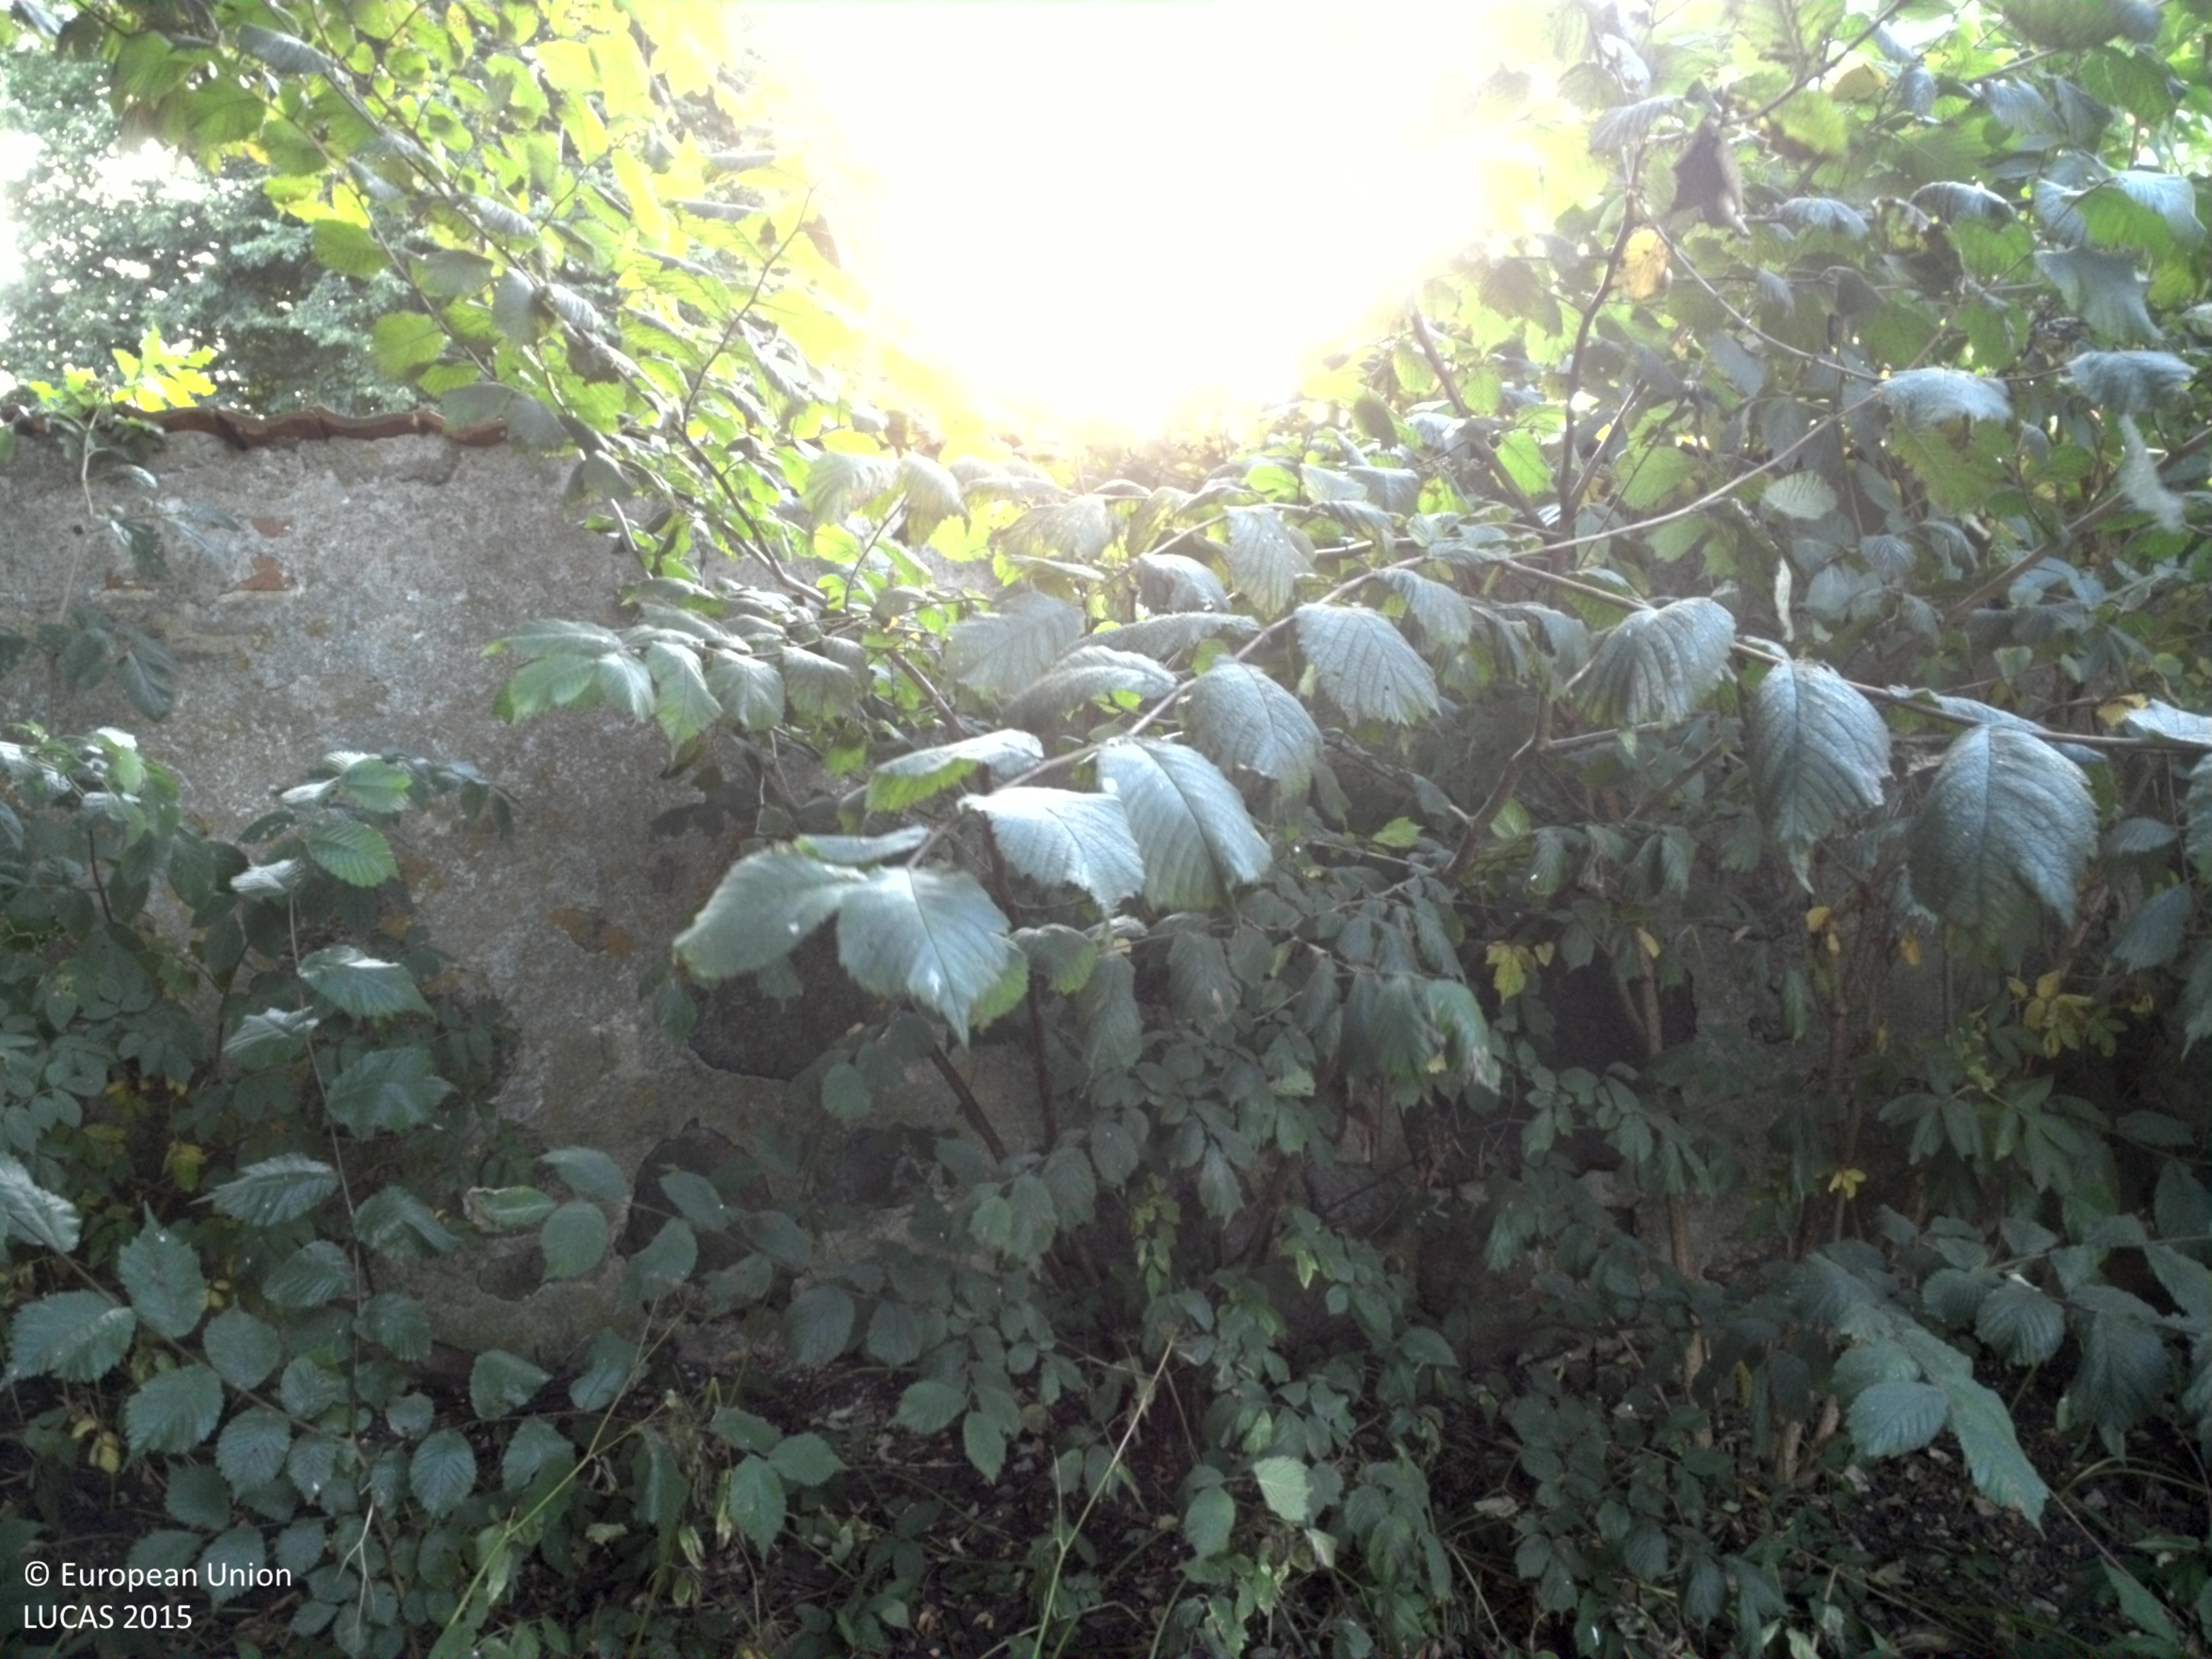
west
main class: Shrubland
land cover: Shrubland with sparse tree cover
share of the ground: 50 - 75 %
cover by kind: shrubs 60 %, herbaceous plants 35 %, broadleaved forest trees 5 %
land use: Residential
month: August
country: SE
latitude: 55.4350
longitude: 13.6176
